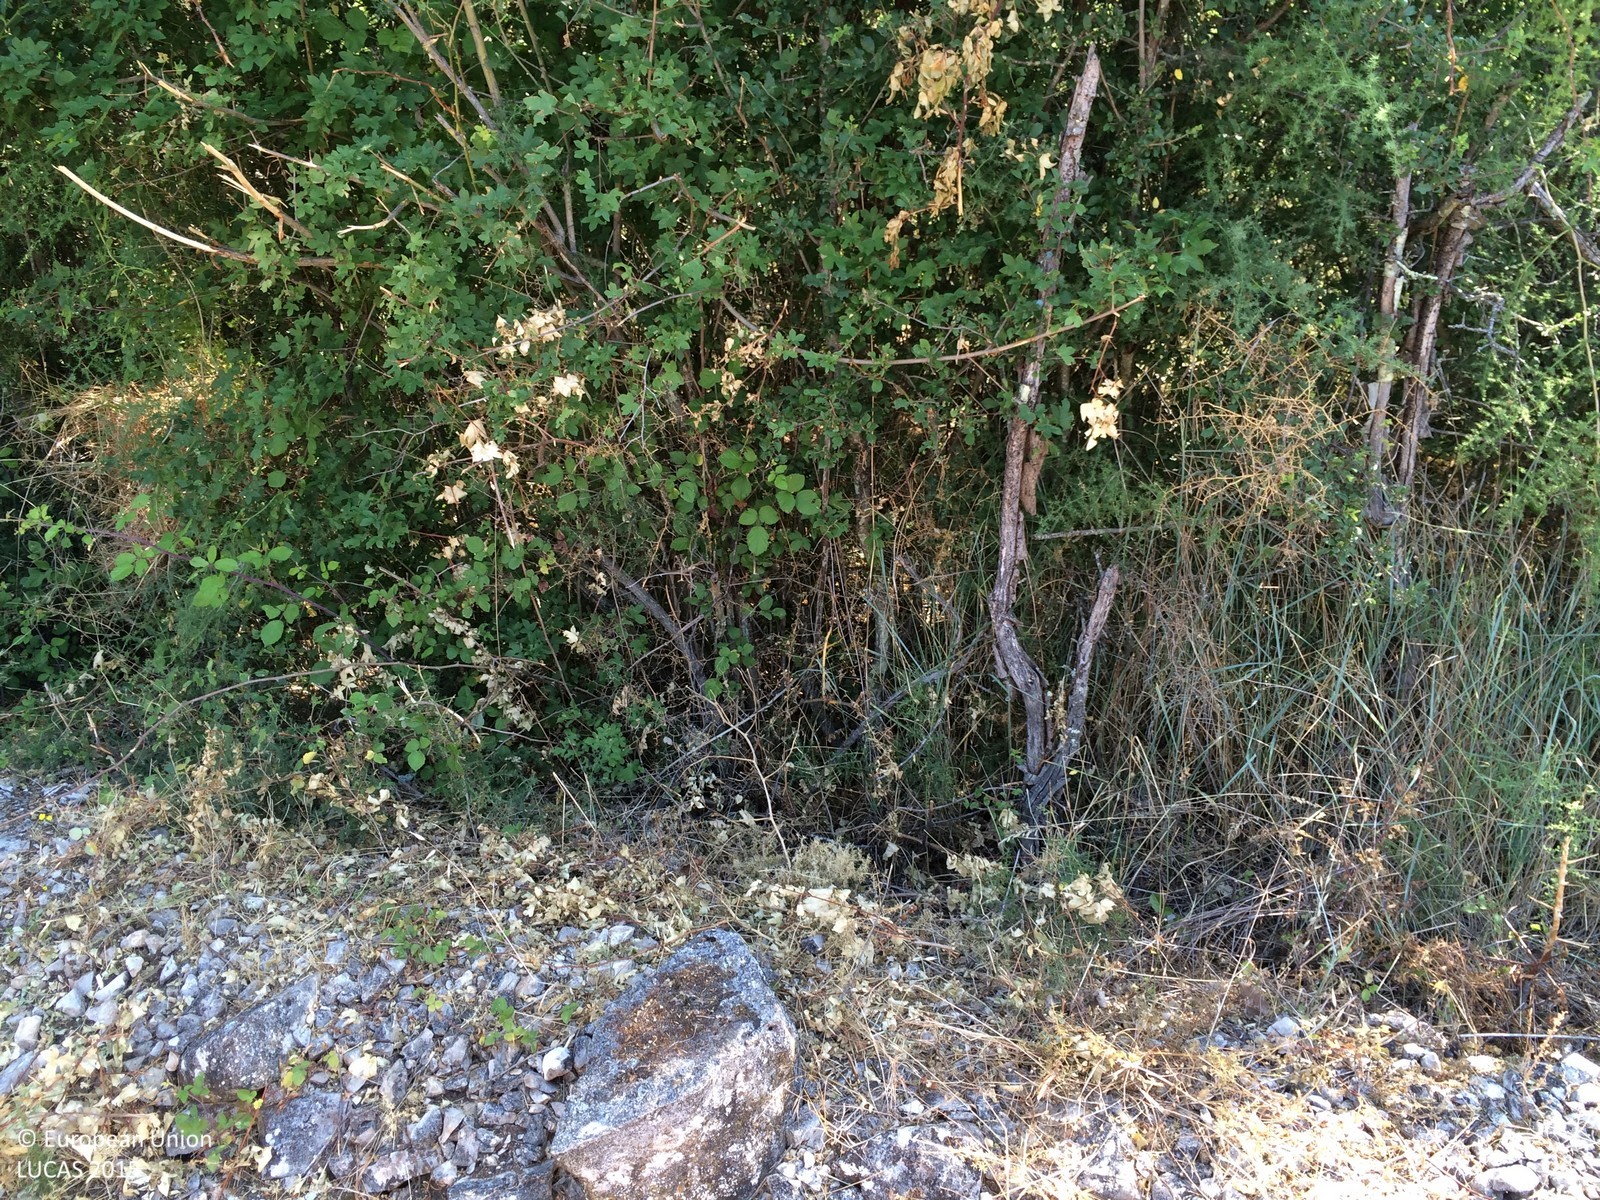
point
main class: Shrubland
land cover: Shrubland with sparse tree cover
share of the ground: < 10 %
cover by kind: shrubs 95 %, broadleaved forest trees 5 %
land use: Semi-natural and natural areas not in use
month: June
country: HR
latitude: 45.0007
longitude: 13.8636
